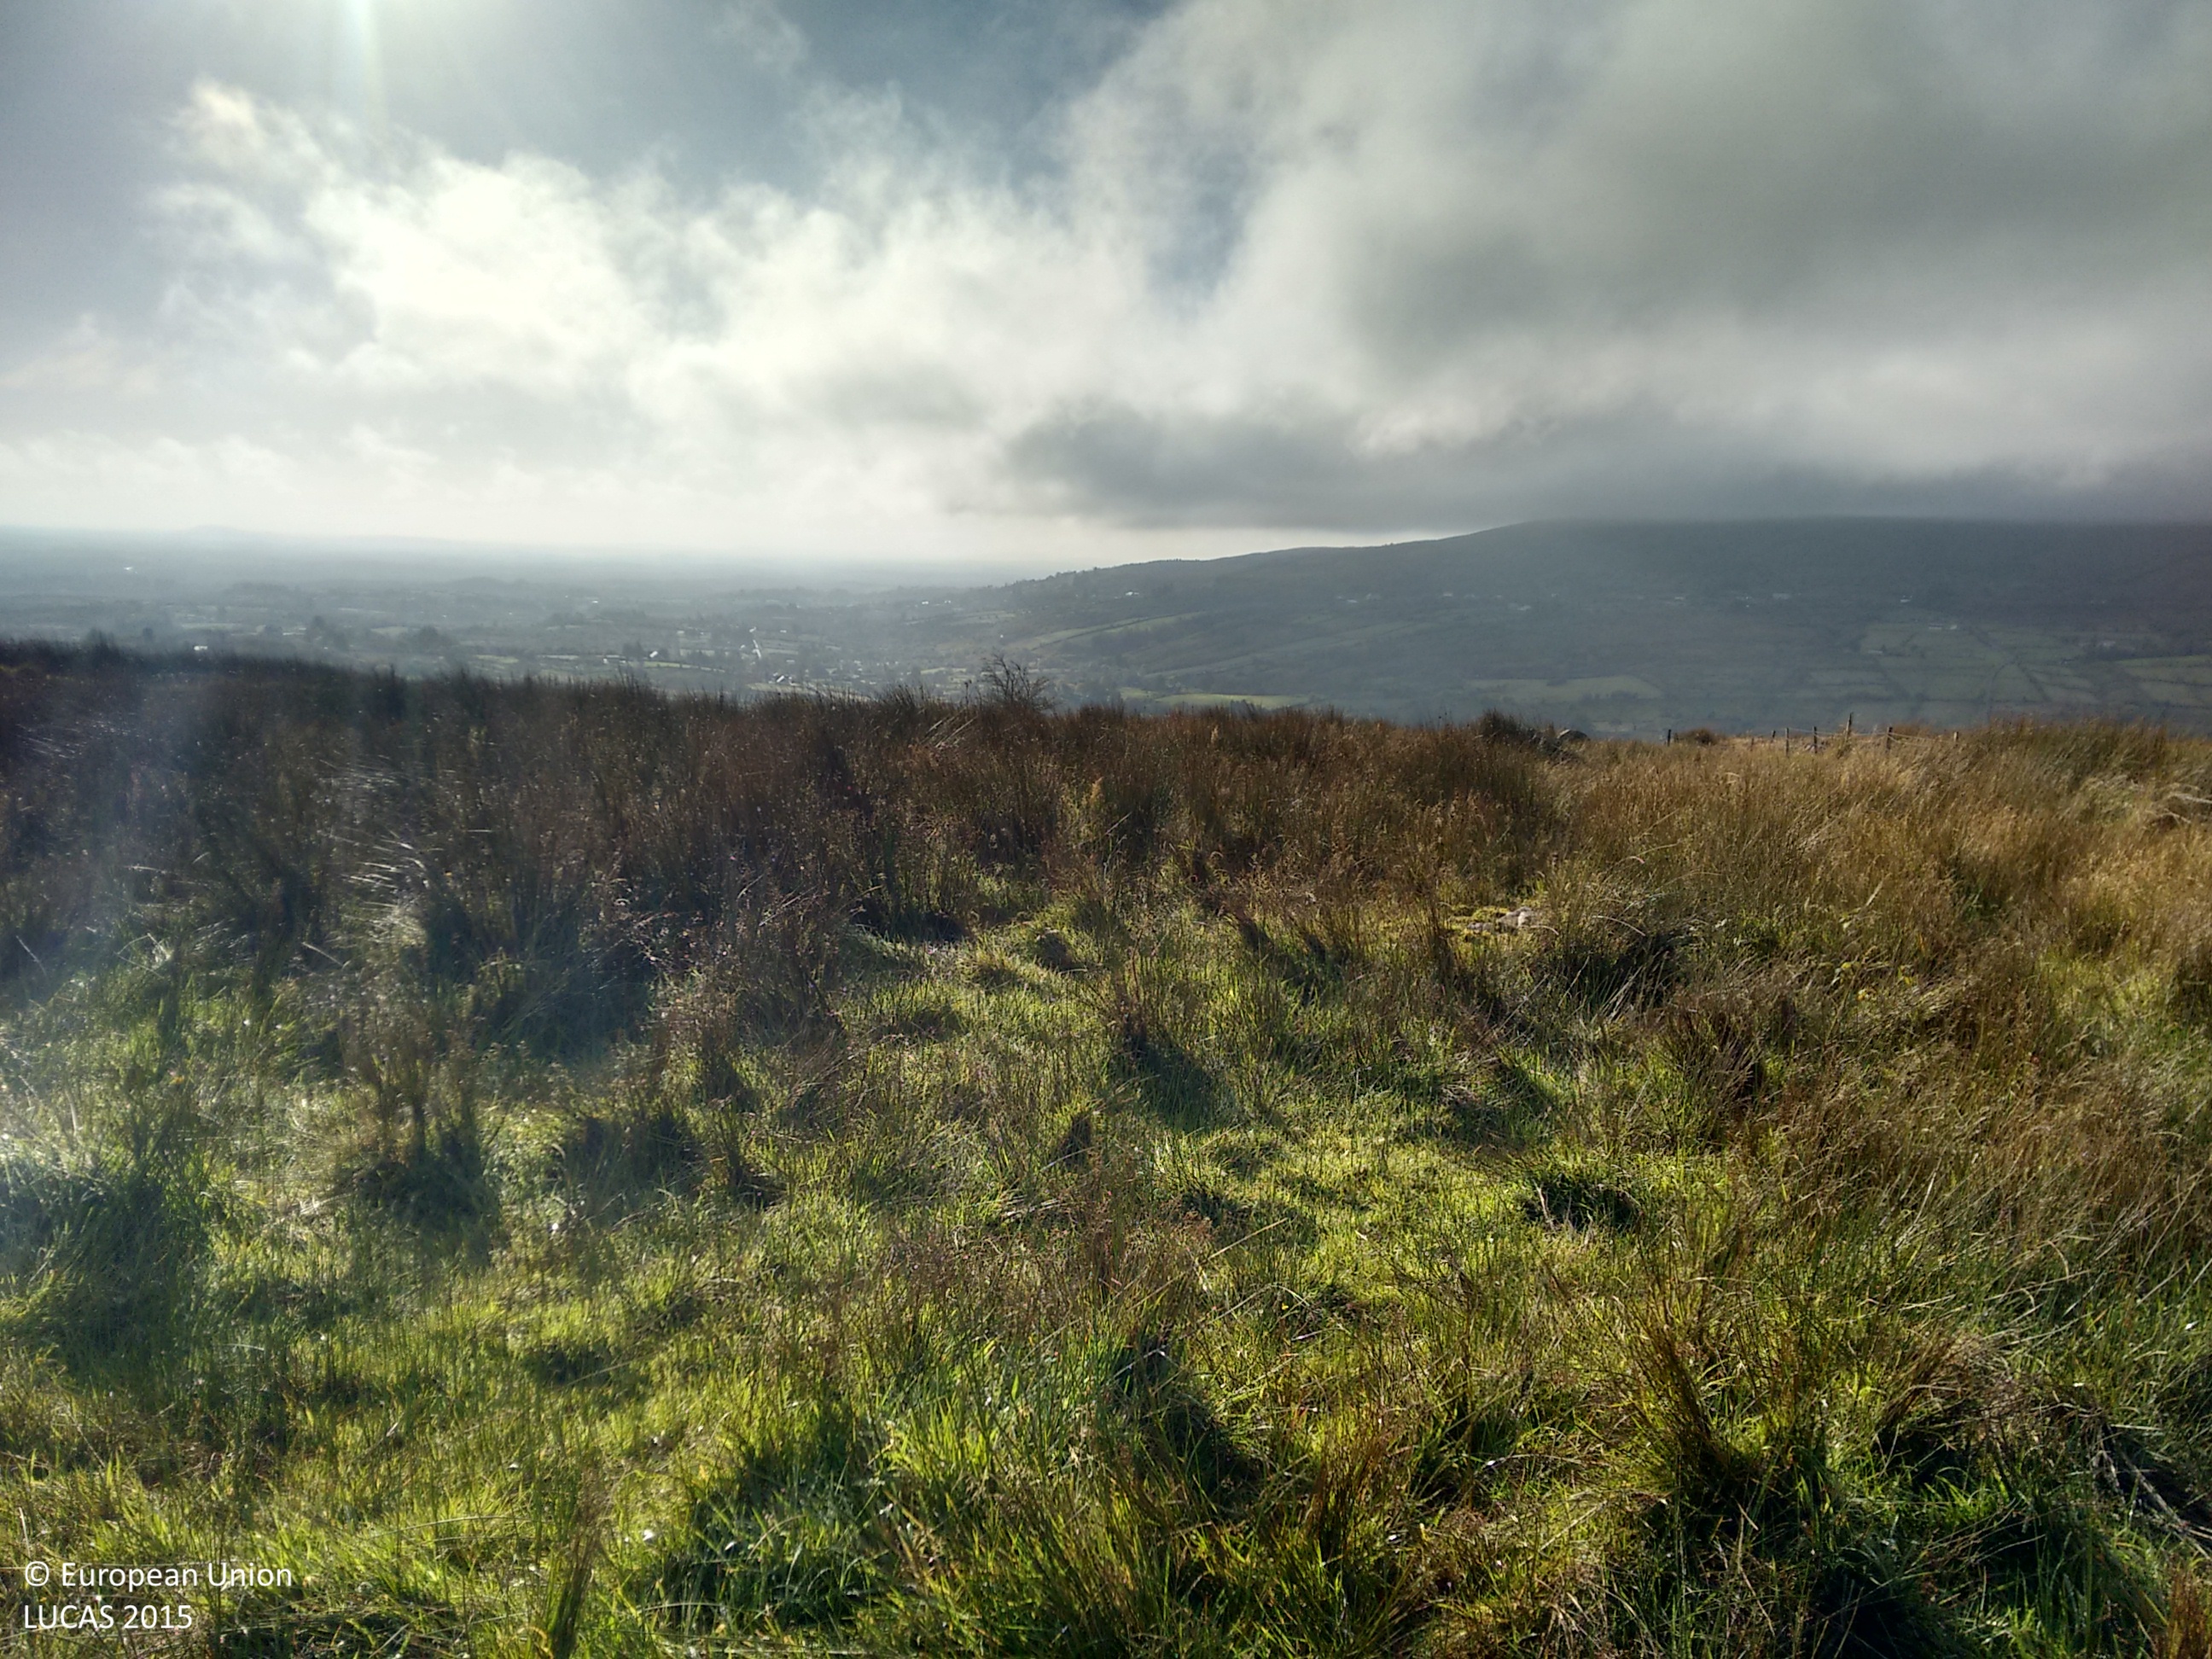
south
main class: Grassland
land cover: Grassland without tree/shrub cover
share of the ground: > 75 %
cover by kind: herbaceous plants 100 %
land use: Agriculture (excluding fallow land and kitchen gardens)
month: October
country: IE
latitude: 54.1045
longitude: -8.1180
